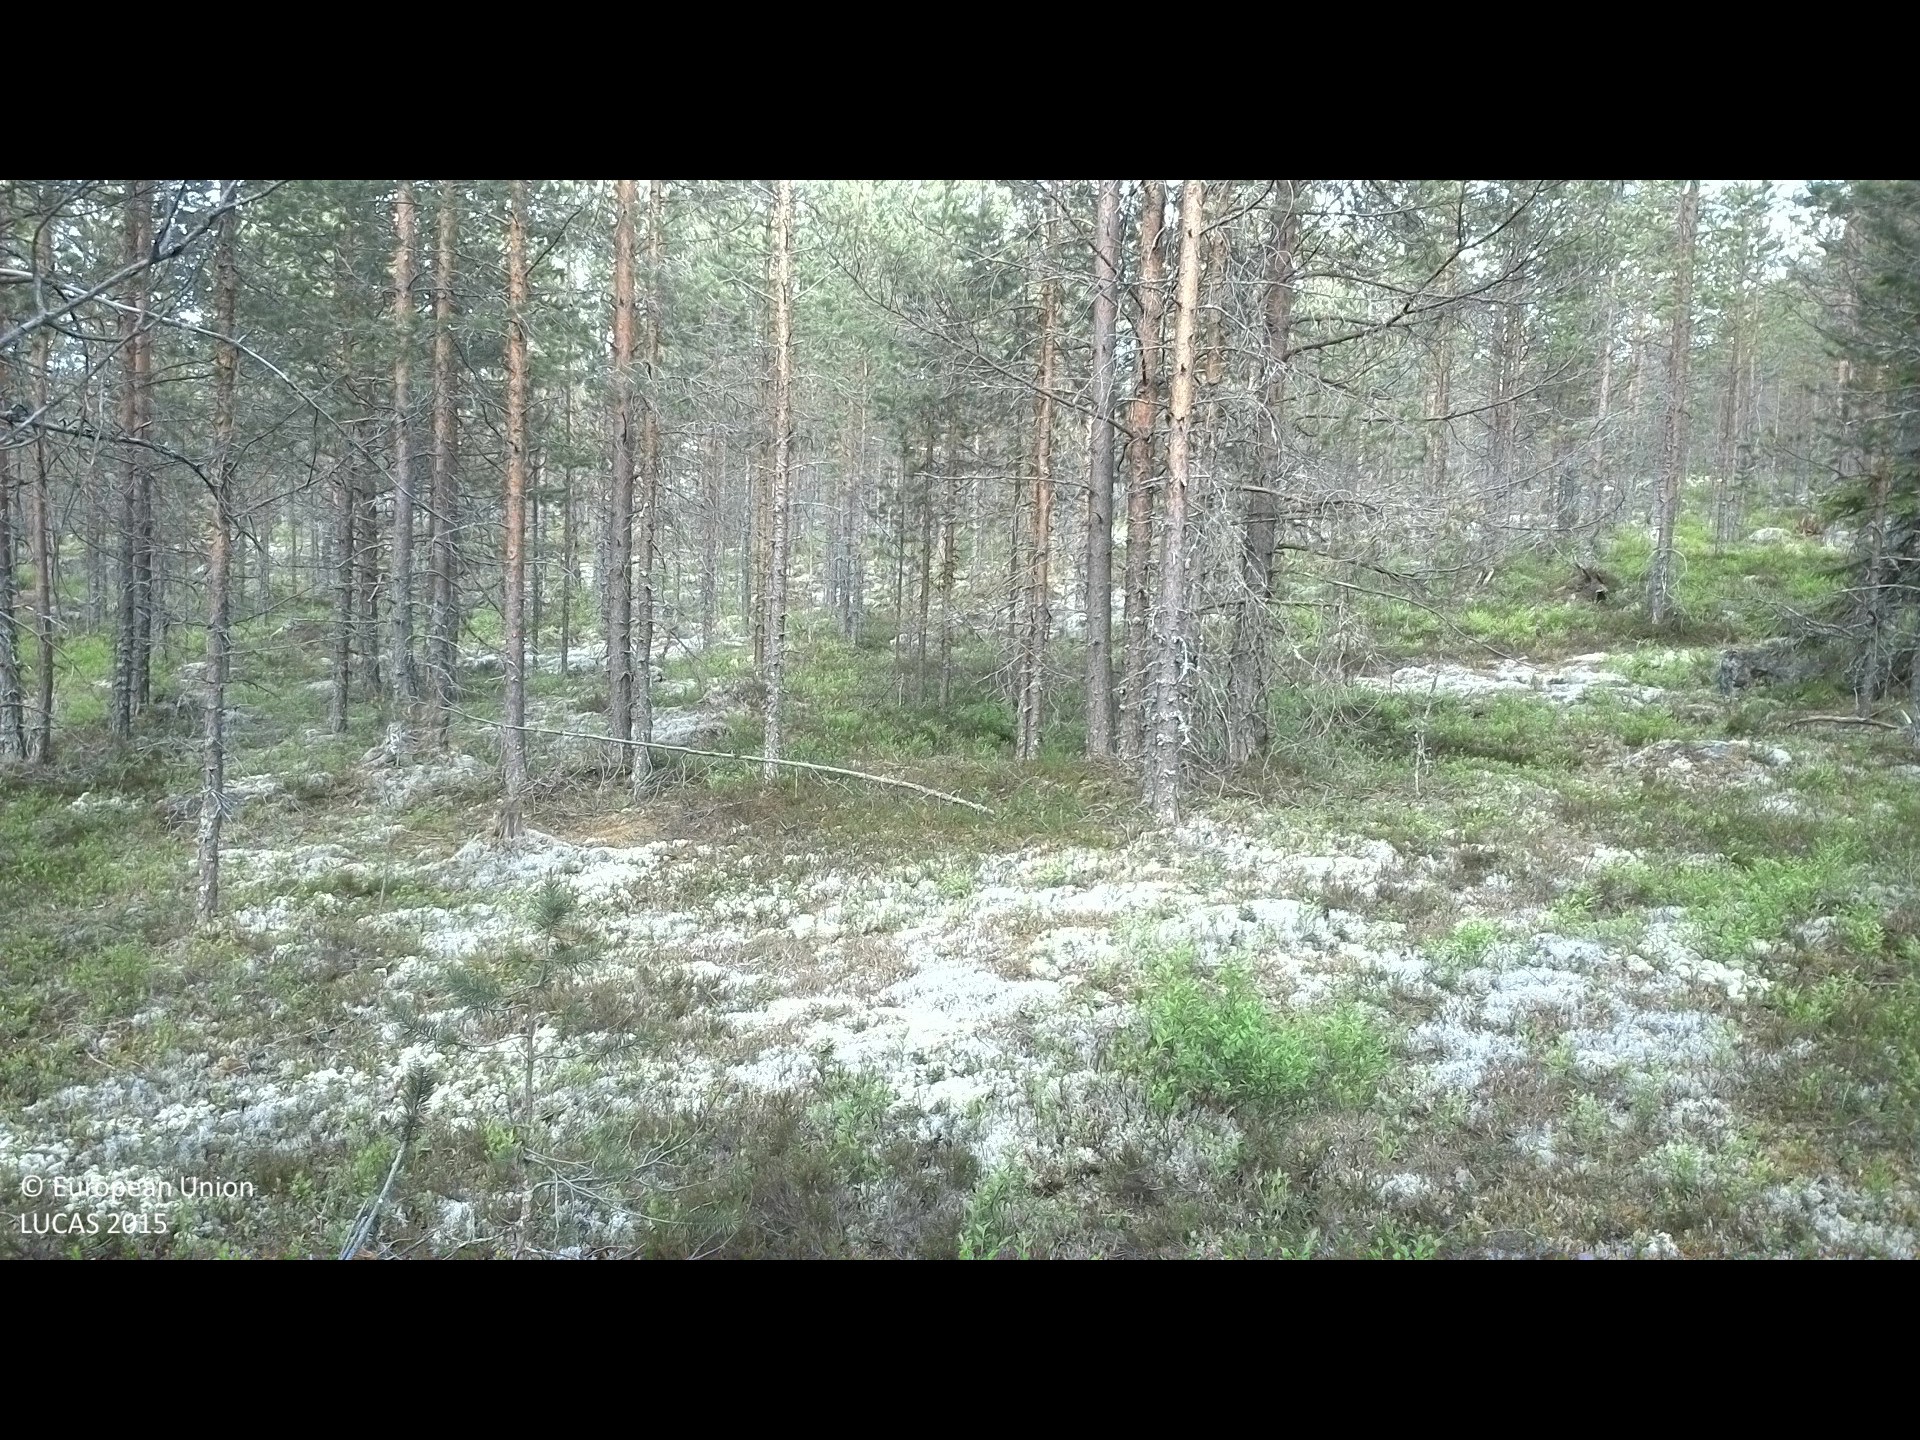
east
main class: Woodland
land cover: Pine dominated coniferous woodland
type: boreal forest
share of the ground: 25 - 50 %
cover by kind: lichens and mosses 50 %, coniferous forest trees 30 %, shrubs 20 %
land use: Forestry
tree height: > 5 m
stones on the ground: < 10 %
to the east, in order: Pine dominated coniferous woodland; Tracks; Pine dominated coniferous woodland
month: June
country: SE
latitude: 61.9576
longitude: 16.6747
